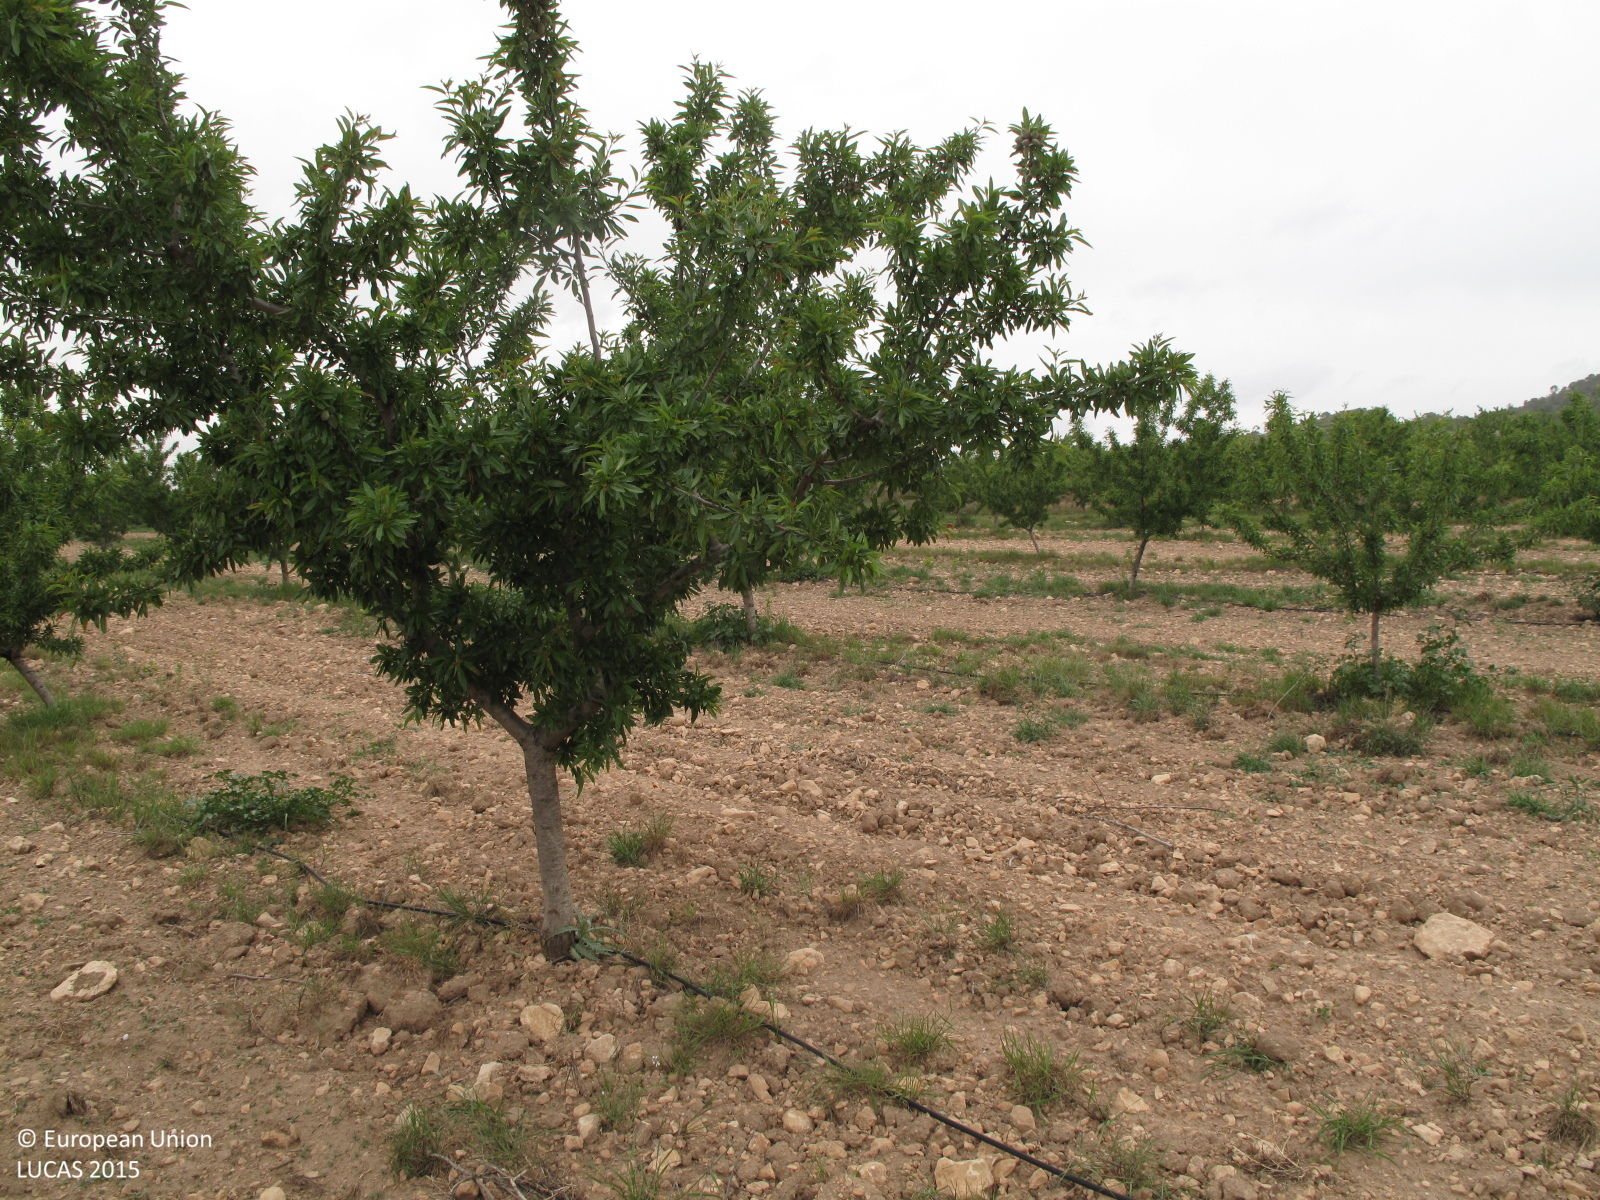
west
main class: Cropland
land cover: Nuts trees
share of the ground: 10 - 25 %
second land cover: Spontaneously vegetated surfaces
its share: 10 - 25 %
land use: Agriculture (excluding fallow land and kitchen gardens)
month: April
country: ES
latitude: 38.4497
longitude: -0.9312
